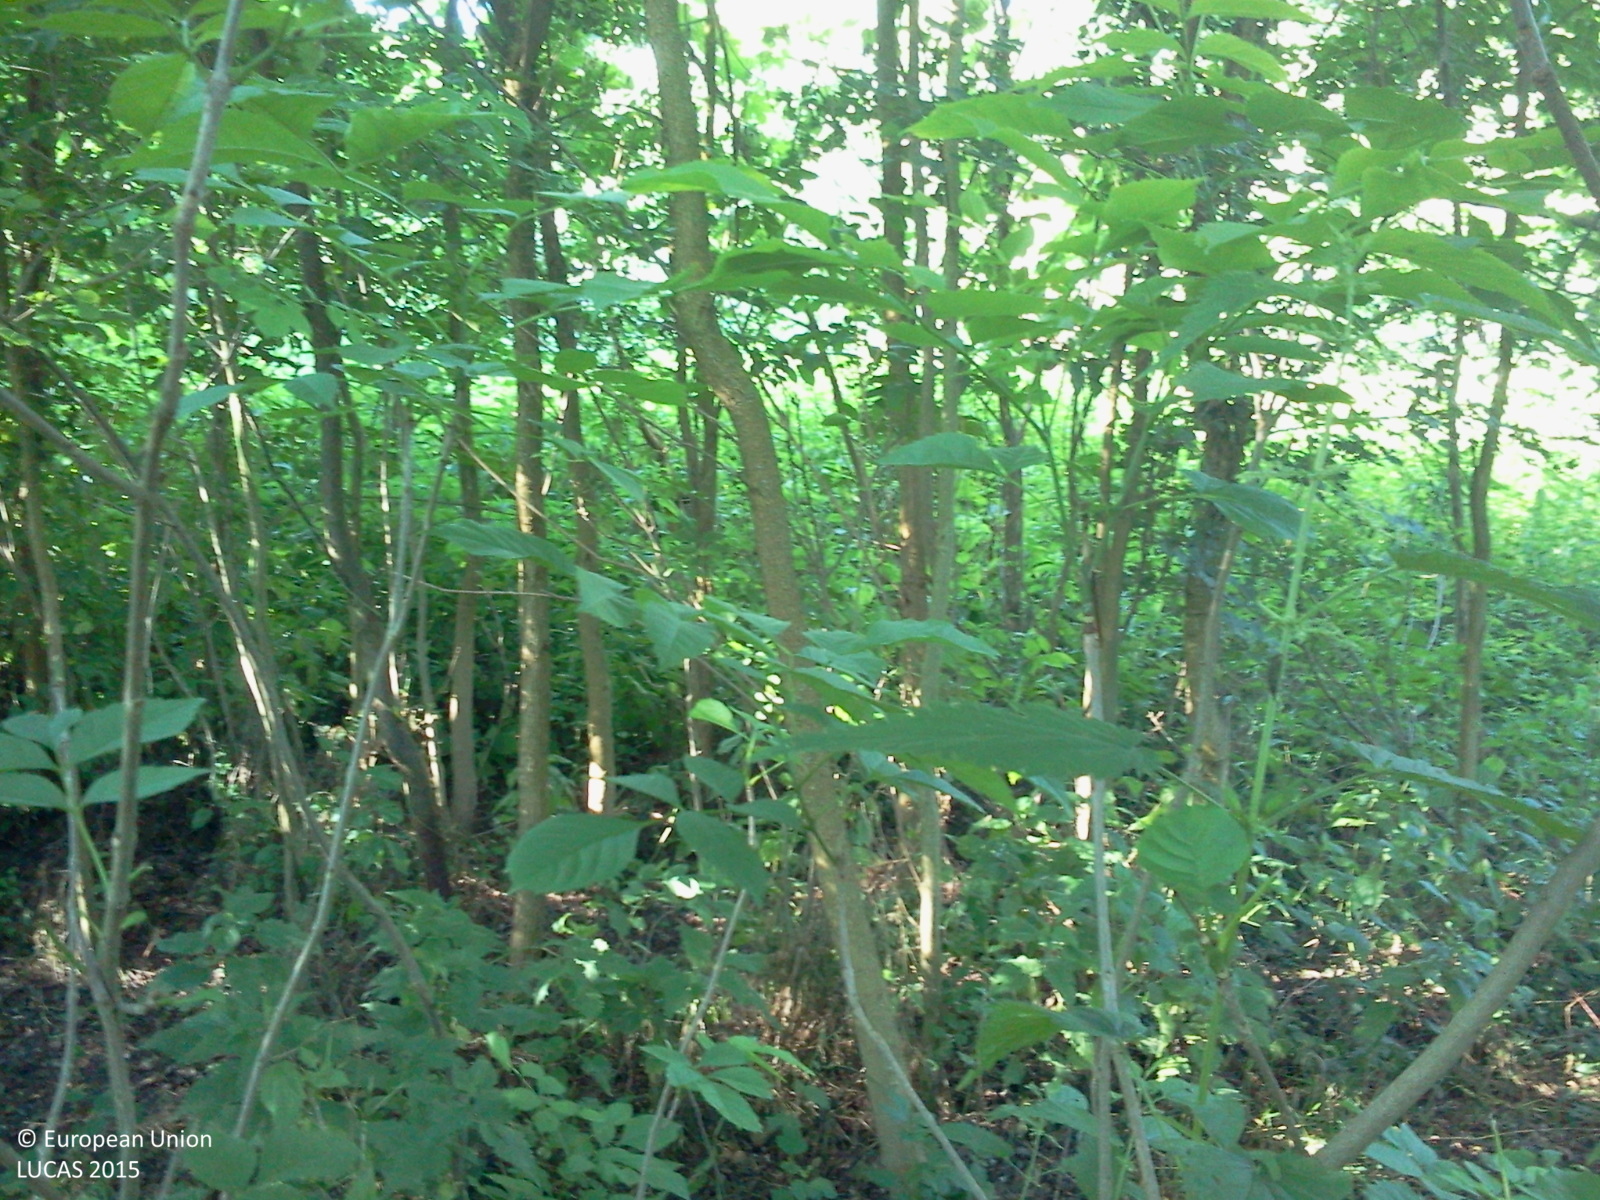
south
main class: Woodland
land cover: Broadleaved woodland
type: thermophilous deciduous forest
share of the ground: > 75 %
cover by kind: broadleaved forest trees 65 %, shrubs 20 %, herbaceous plants 15 %
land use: Forestry
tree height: > 5 m
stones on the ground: < 10 %
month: June
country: HU
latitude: 46.6950
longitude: 17.0784
